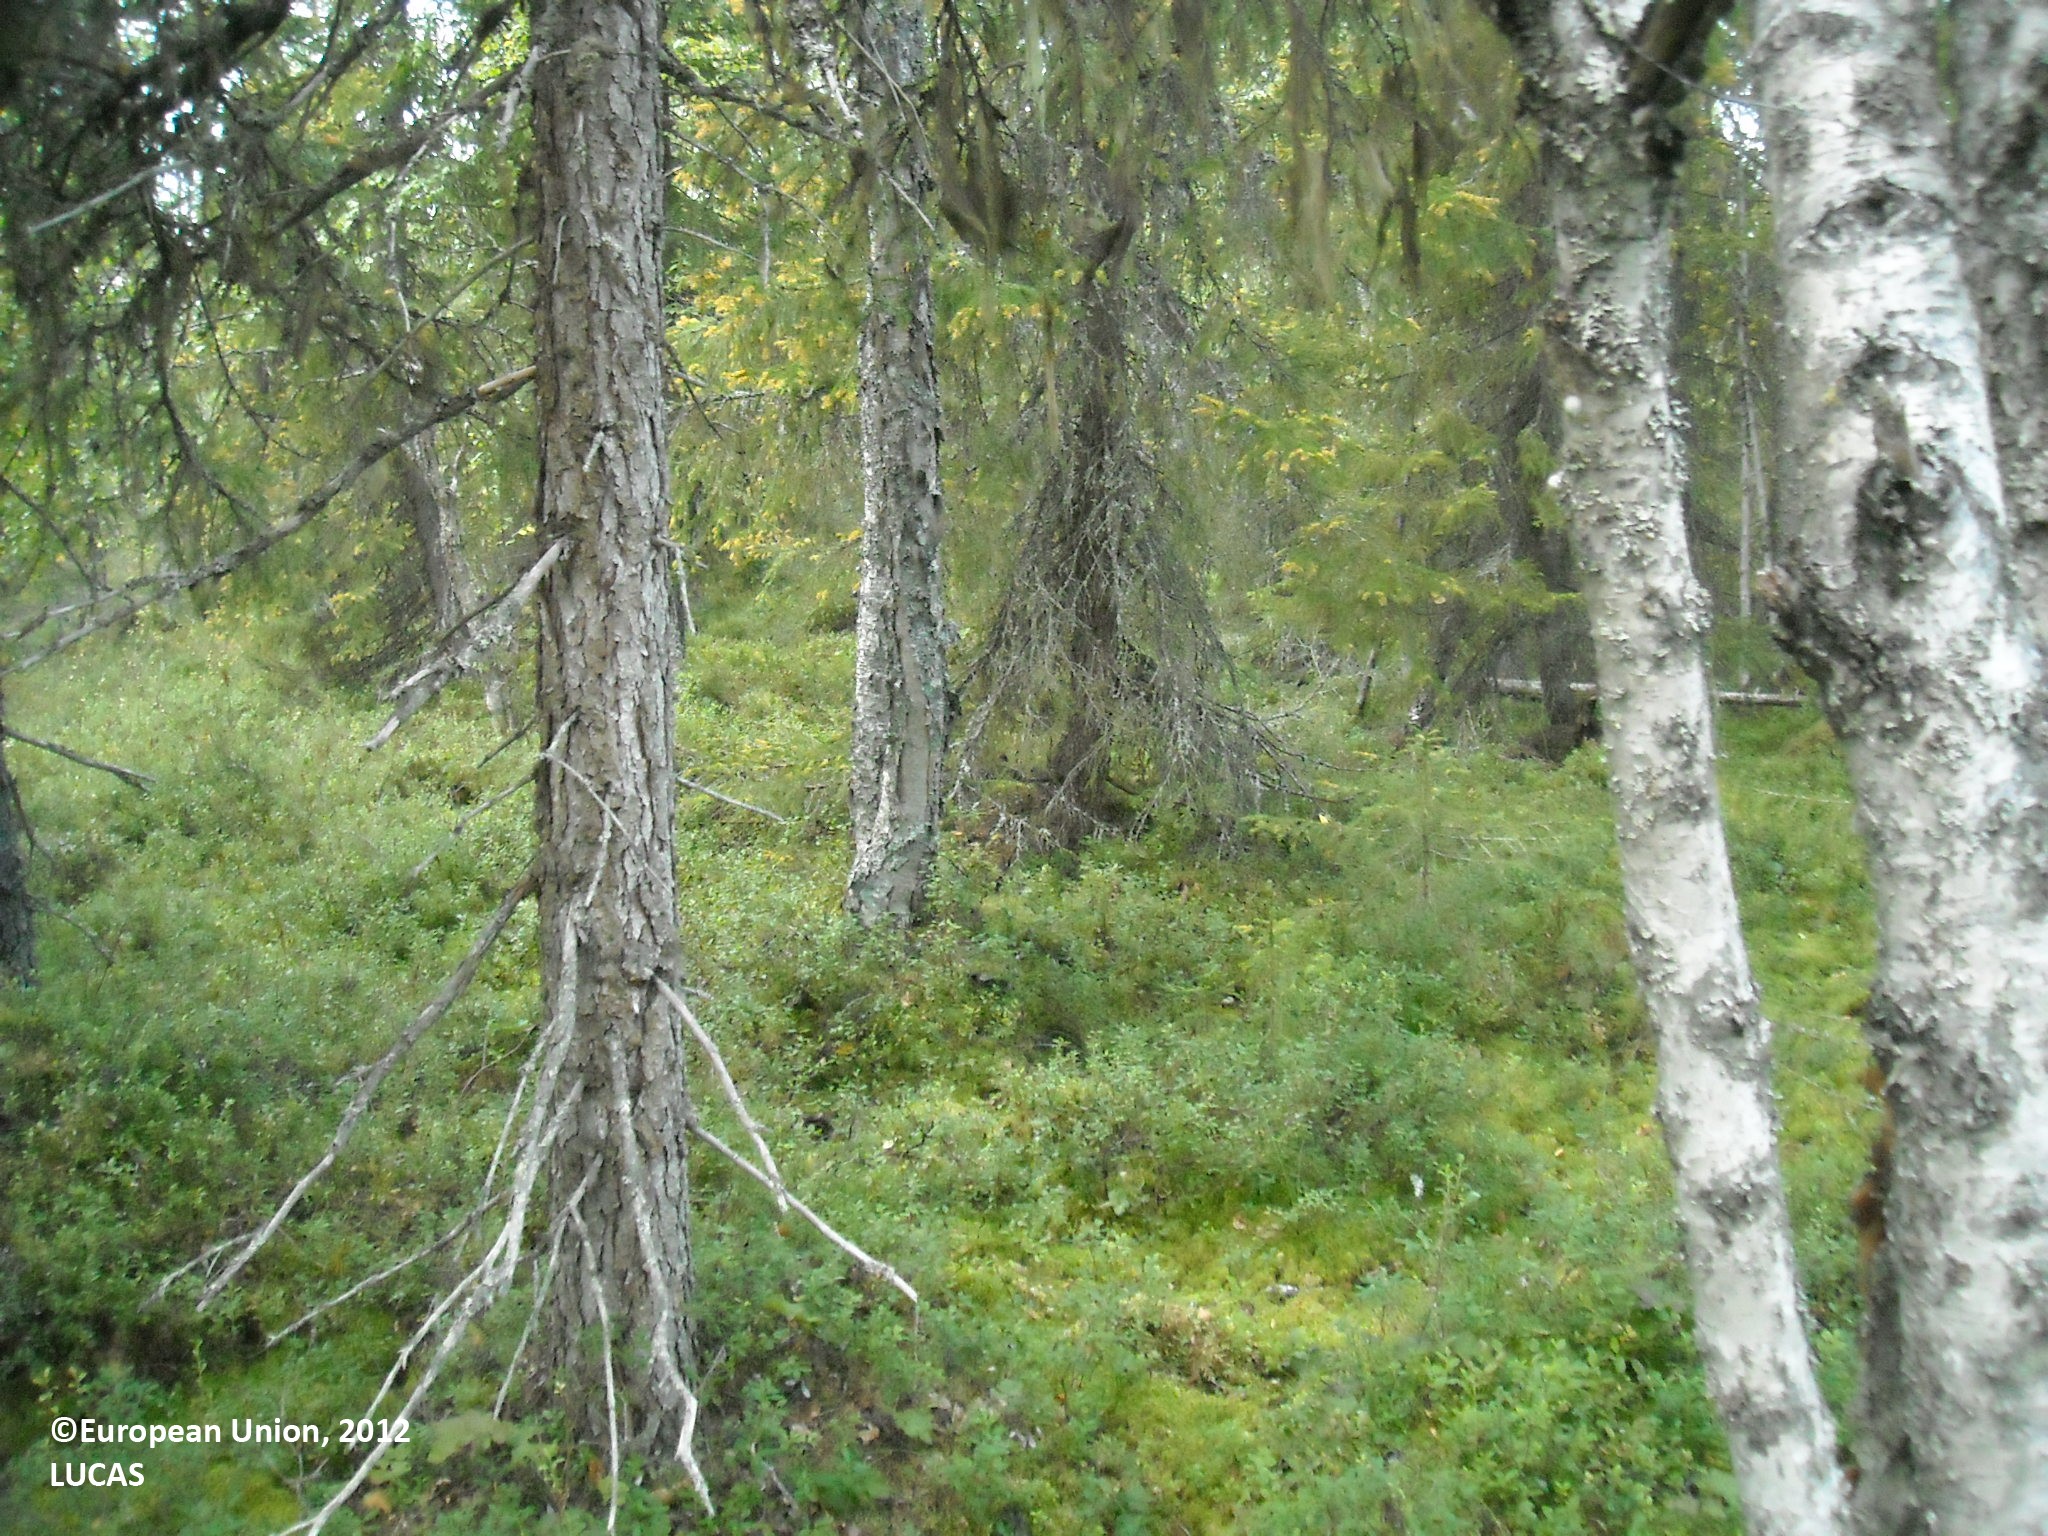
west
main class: Woodland
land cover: Spruce dominated mixed woodland
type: mire and swamp forests
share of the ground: > 75 %
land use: Forestry
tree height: > 5 m
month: August
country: FI
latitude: 65.4345
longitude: 27.7502
